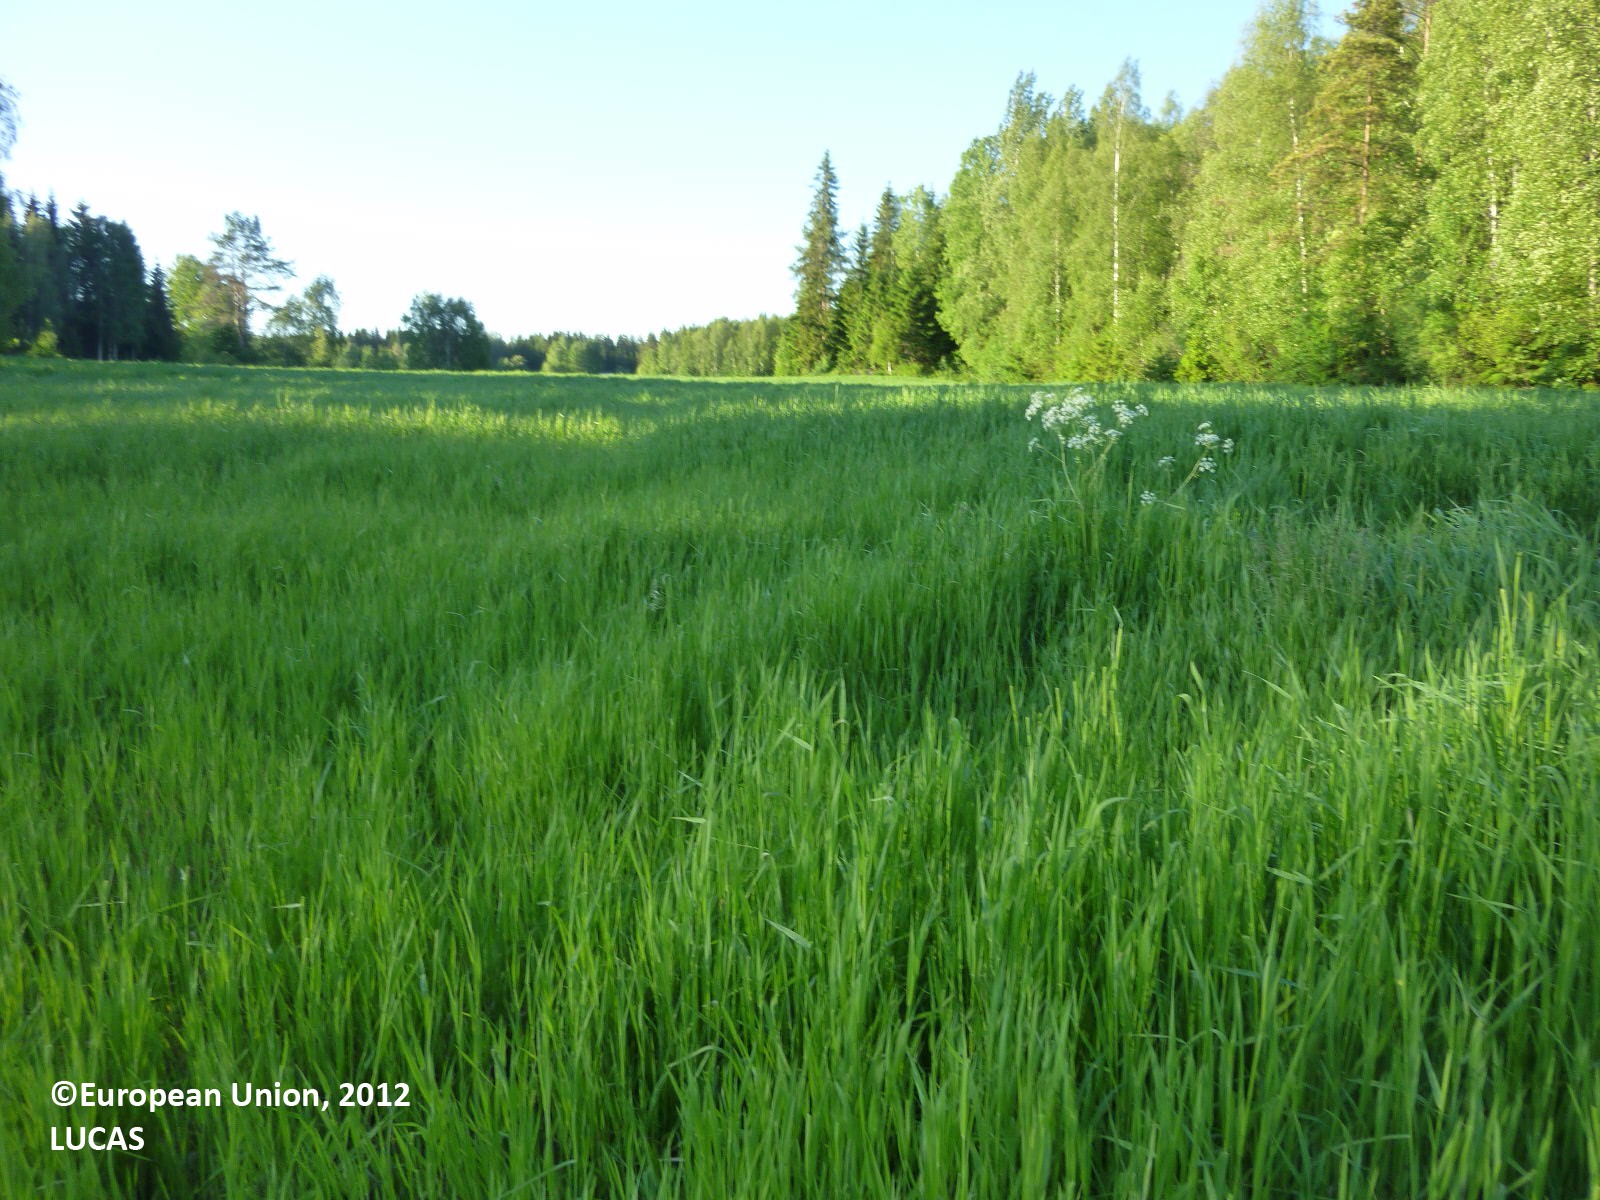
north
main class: Cropland
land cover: Temporary grasslands
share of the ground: > 75 %
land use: Agriculture (excluding fallow land and kitchen gardens)
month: June
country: FI
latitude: 61.6458
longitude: 22.1183
